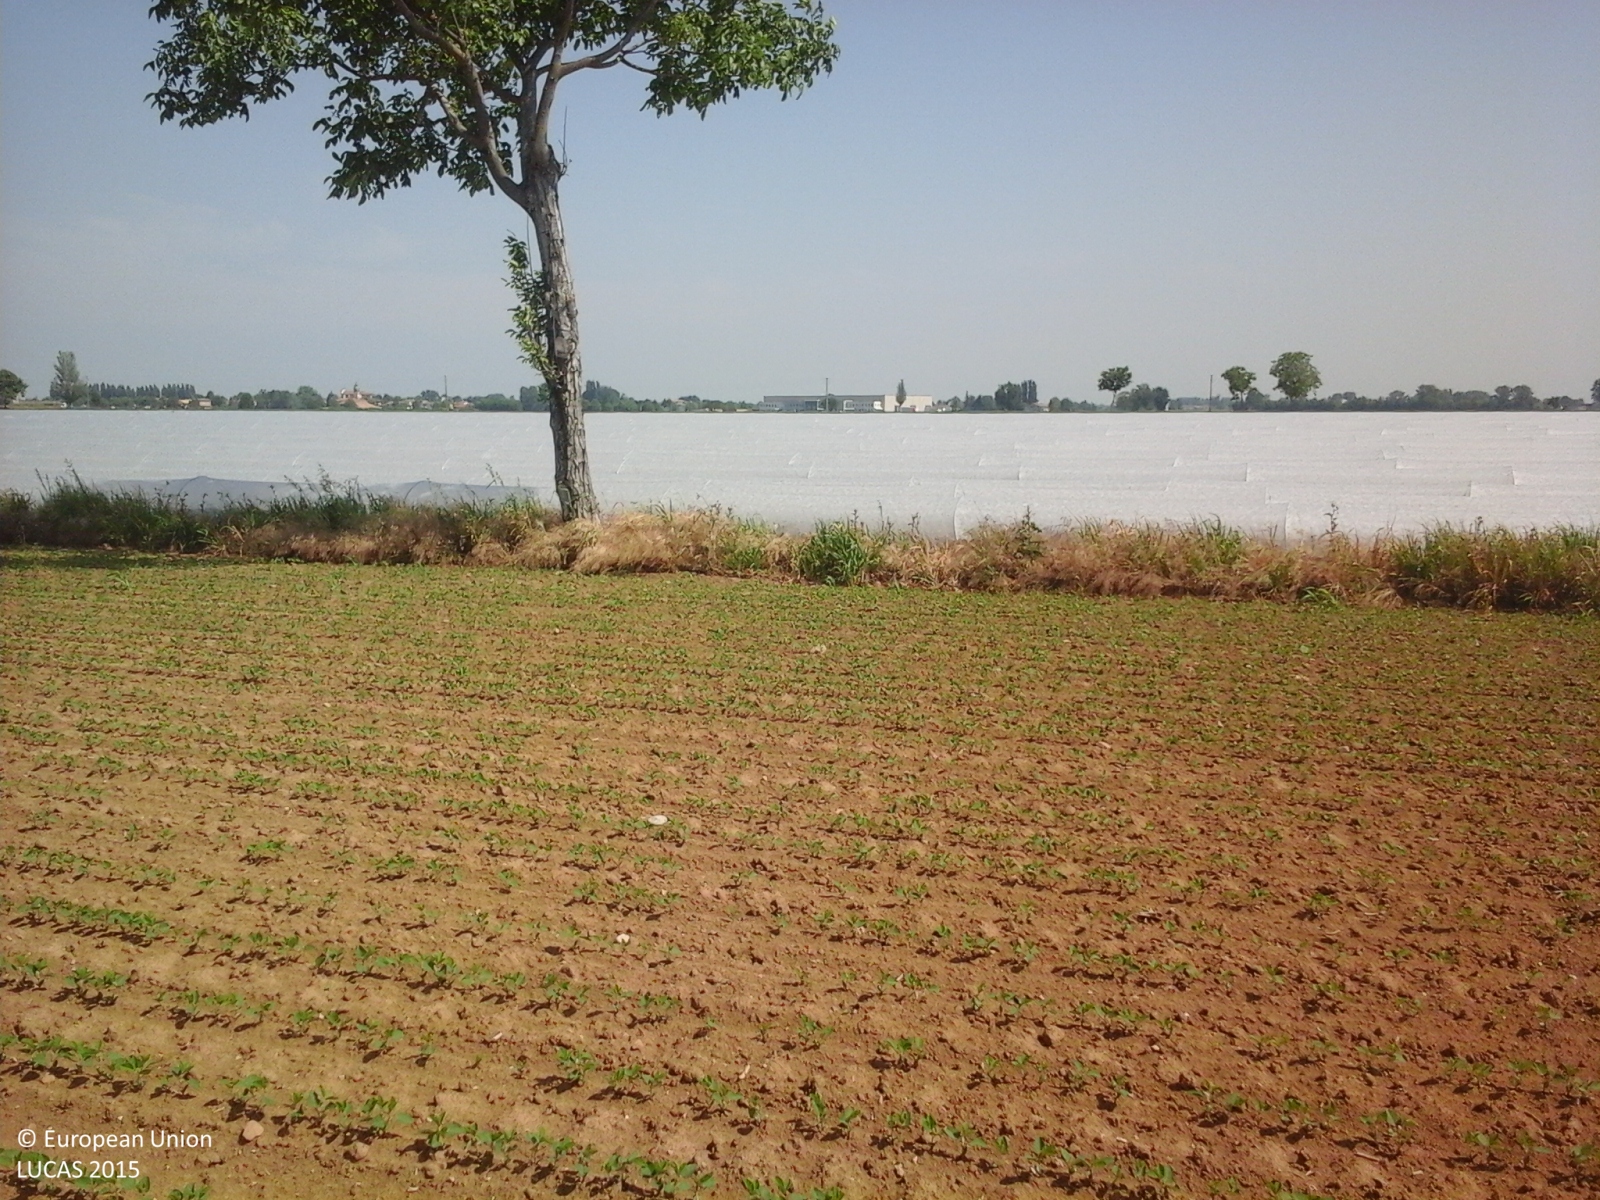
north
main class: Cropland
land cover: Soya
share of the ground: < 10 %
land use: Agriculture (excluding fallow land and kitchen gardens)
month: May
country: IT
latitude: 45.1601
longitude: 10.6222
